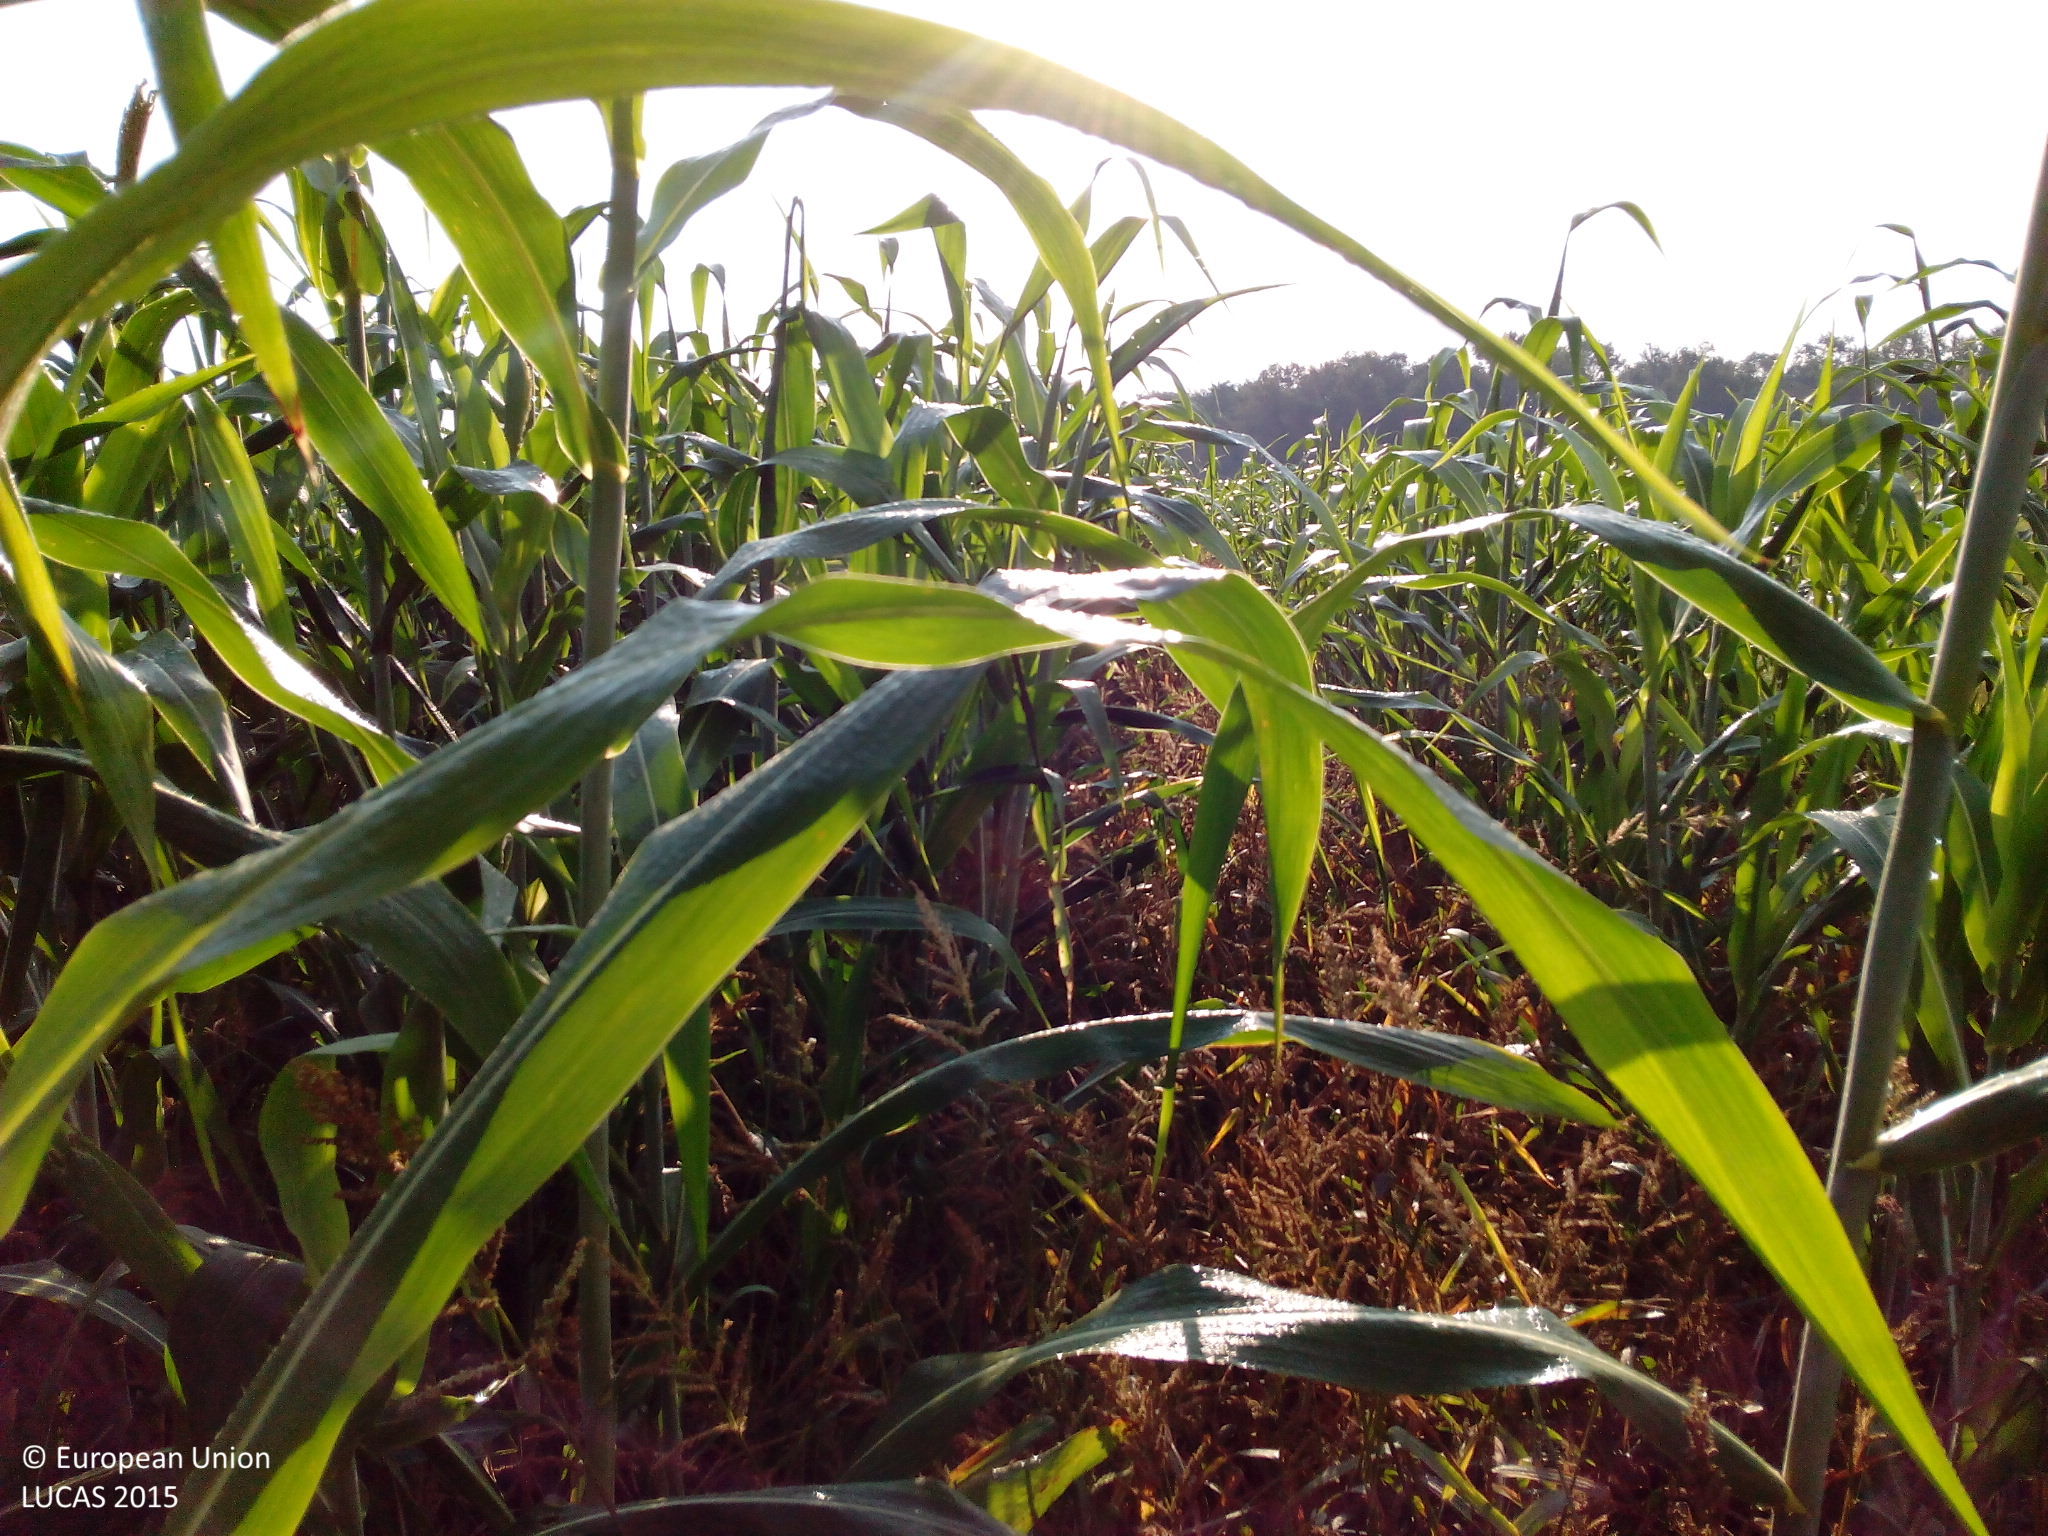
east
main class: Cropland
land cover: Maize
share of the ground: > 75 %
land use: Agriculture (excluding fallow land and kitchen gardens)
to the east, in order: Maize; Grass margins; Tracks; Grass margins; Sugar beet
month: August
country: DE
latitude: 48.4930
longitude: 10.3111
